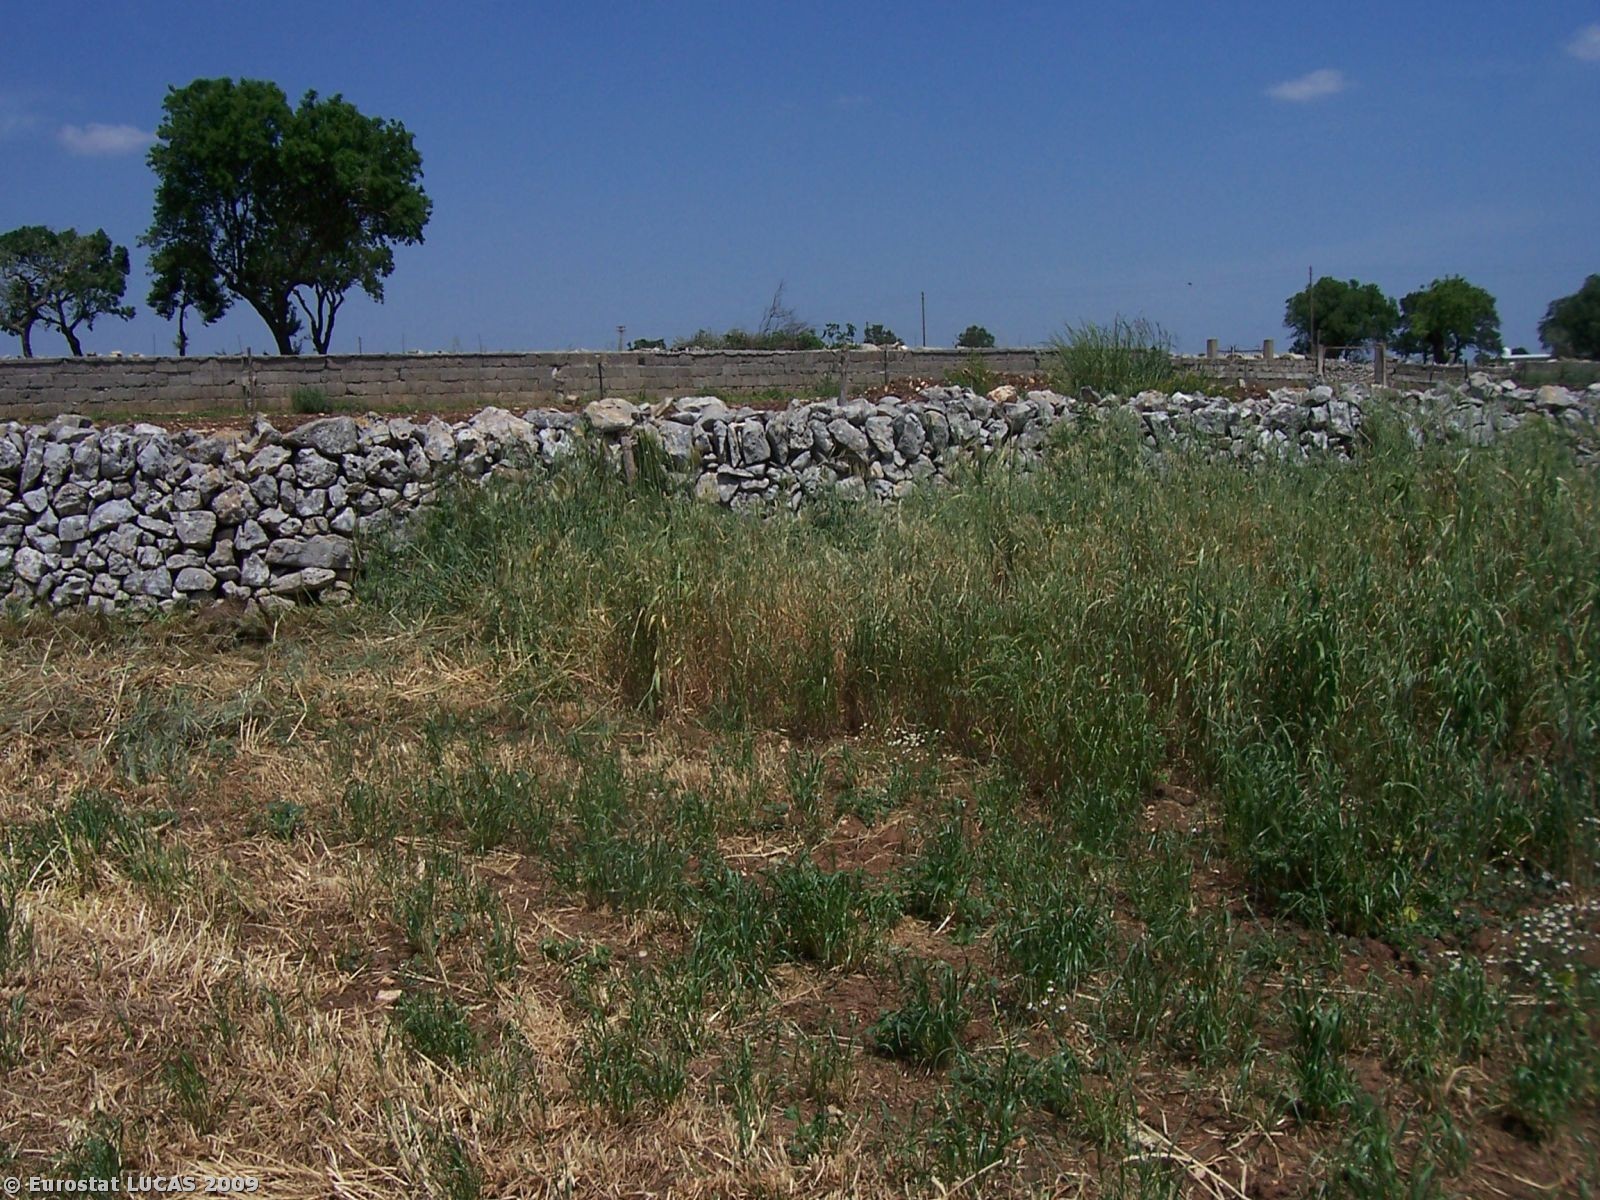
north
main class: Cropland
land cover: Other leguminous and mixtures for fodder
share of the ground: < 10 %
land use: Agriculture (excluding fallow land and kitchen gardens)
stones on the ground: < 10 %
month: May
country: IT
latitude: 40.7449
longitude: 16.9764
